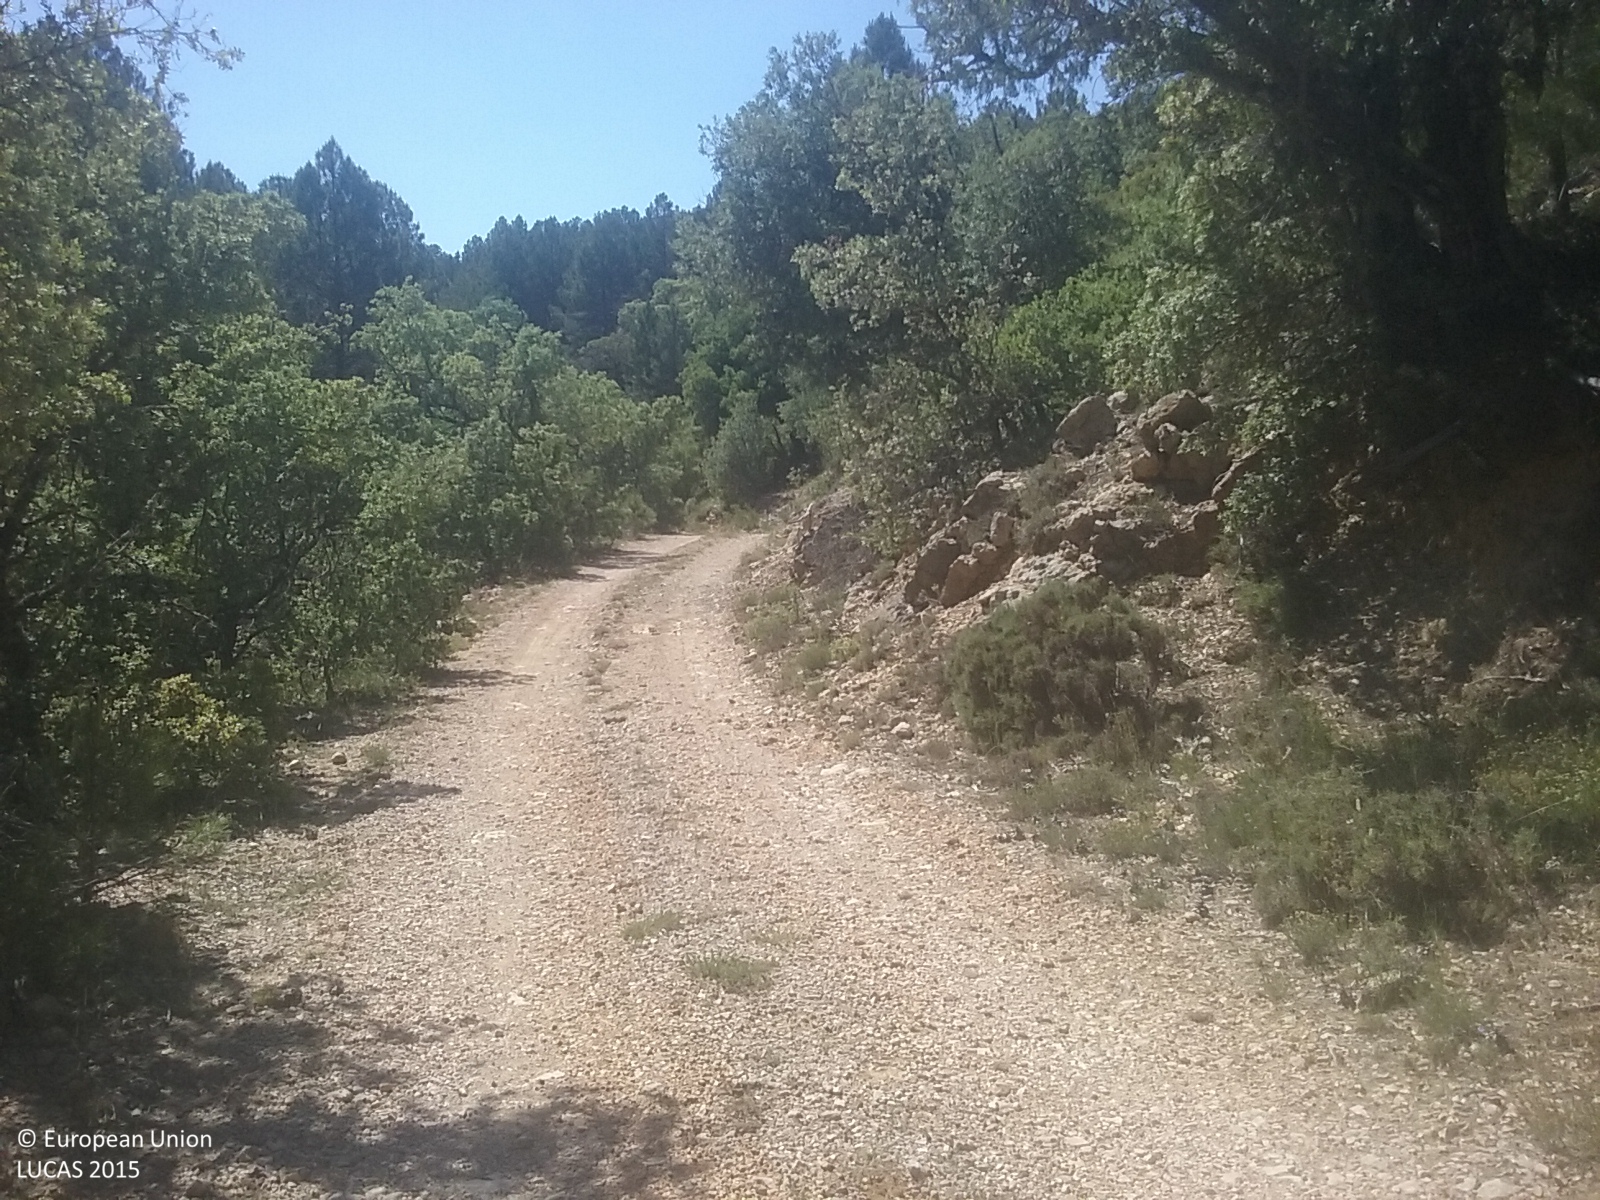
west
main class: Woodland
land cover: Pine dominated mixed woodland
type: coniferous forest of the mediterranean region
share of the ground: > 75 %
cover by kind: coniferous forest trees 40 %, broadleaved forest trees 40 %, shrubs 10 %, unconsolidated bare surface 10 %
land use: Forestry
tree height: > 5 m
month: June
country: ES
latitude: 40.6453
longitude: -0.0232
